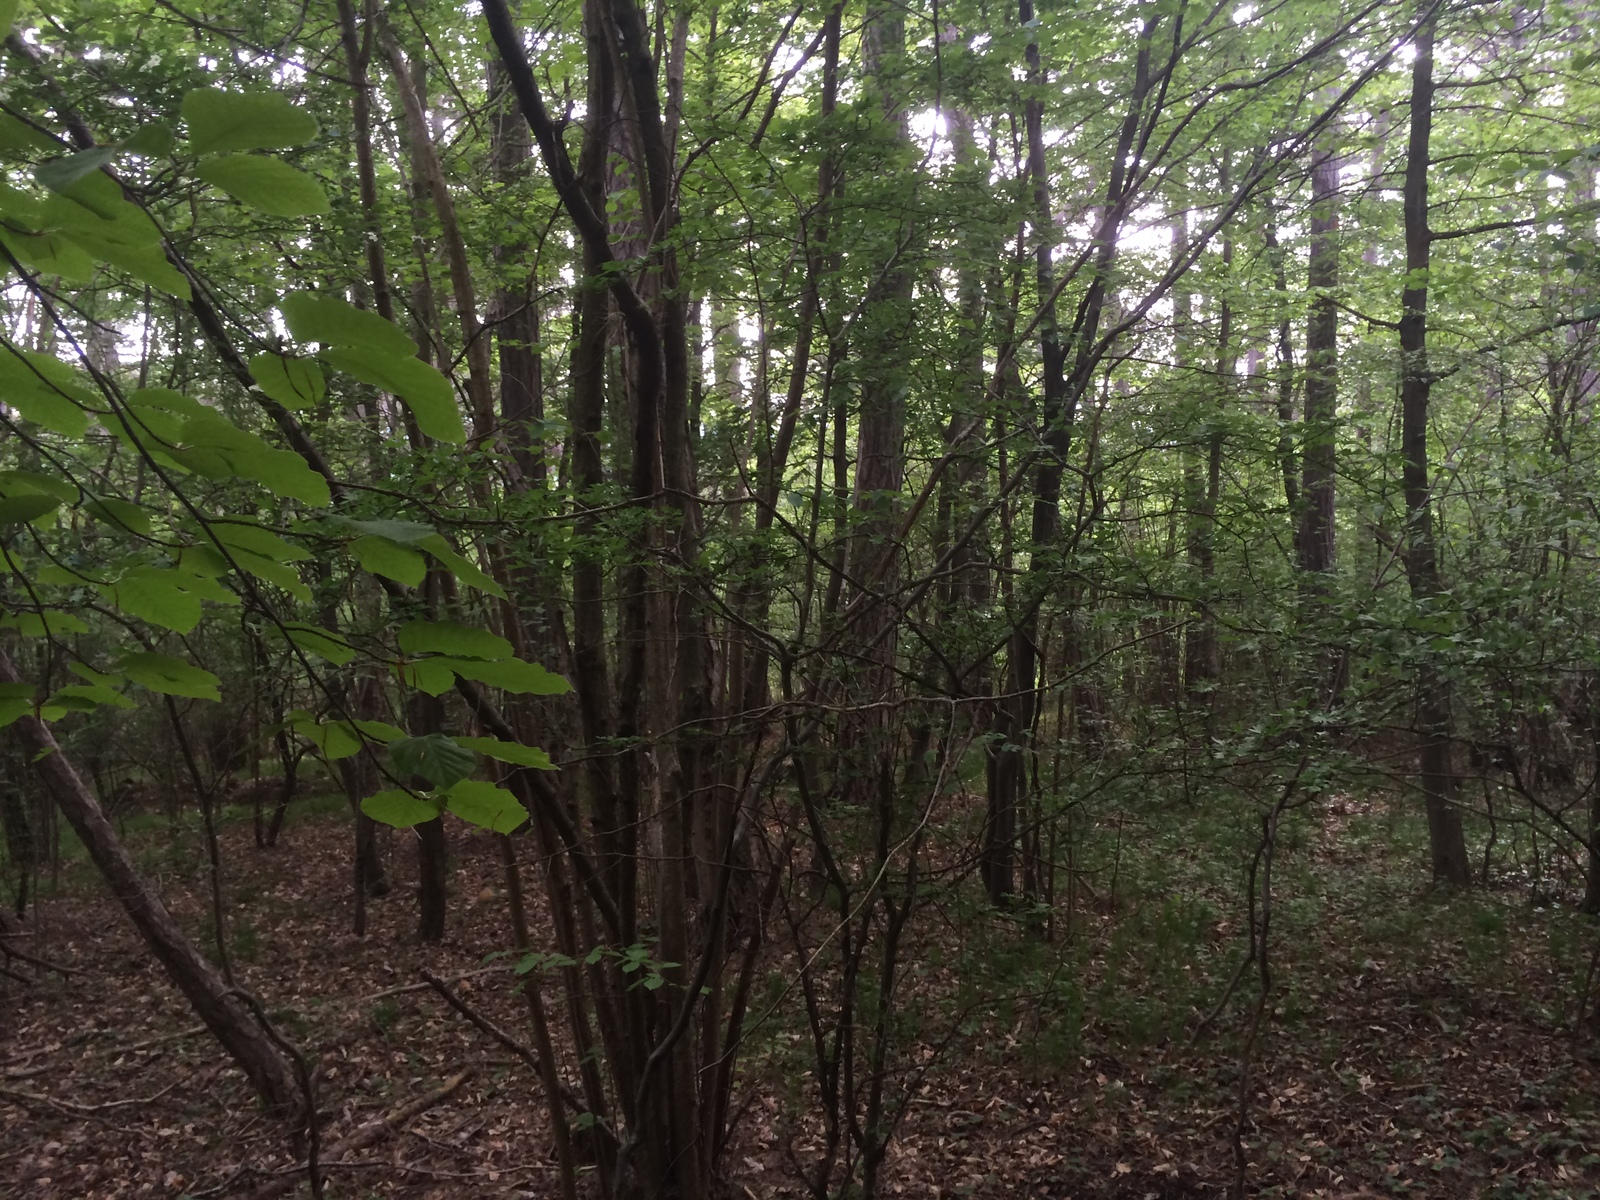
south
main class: Woodland
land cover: Pine dominated mixed woodland
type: hemiboreal forest and nemoral coniferous forest and mixed broadleaved-coniferous forest
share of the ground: > 75 %
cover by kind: coniferous forest trees 50 %, broadleaved forest trees 50 %
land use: Forestry
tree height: > 5 m
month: May
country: AT
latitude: 47.9272
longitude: 16.1199
